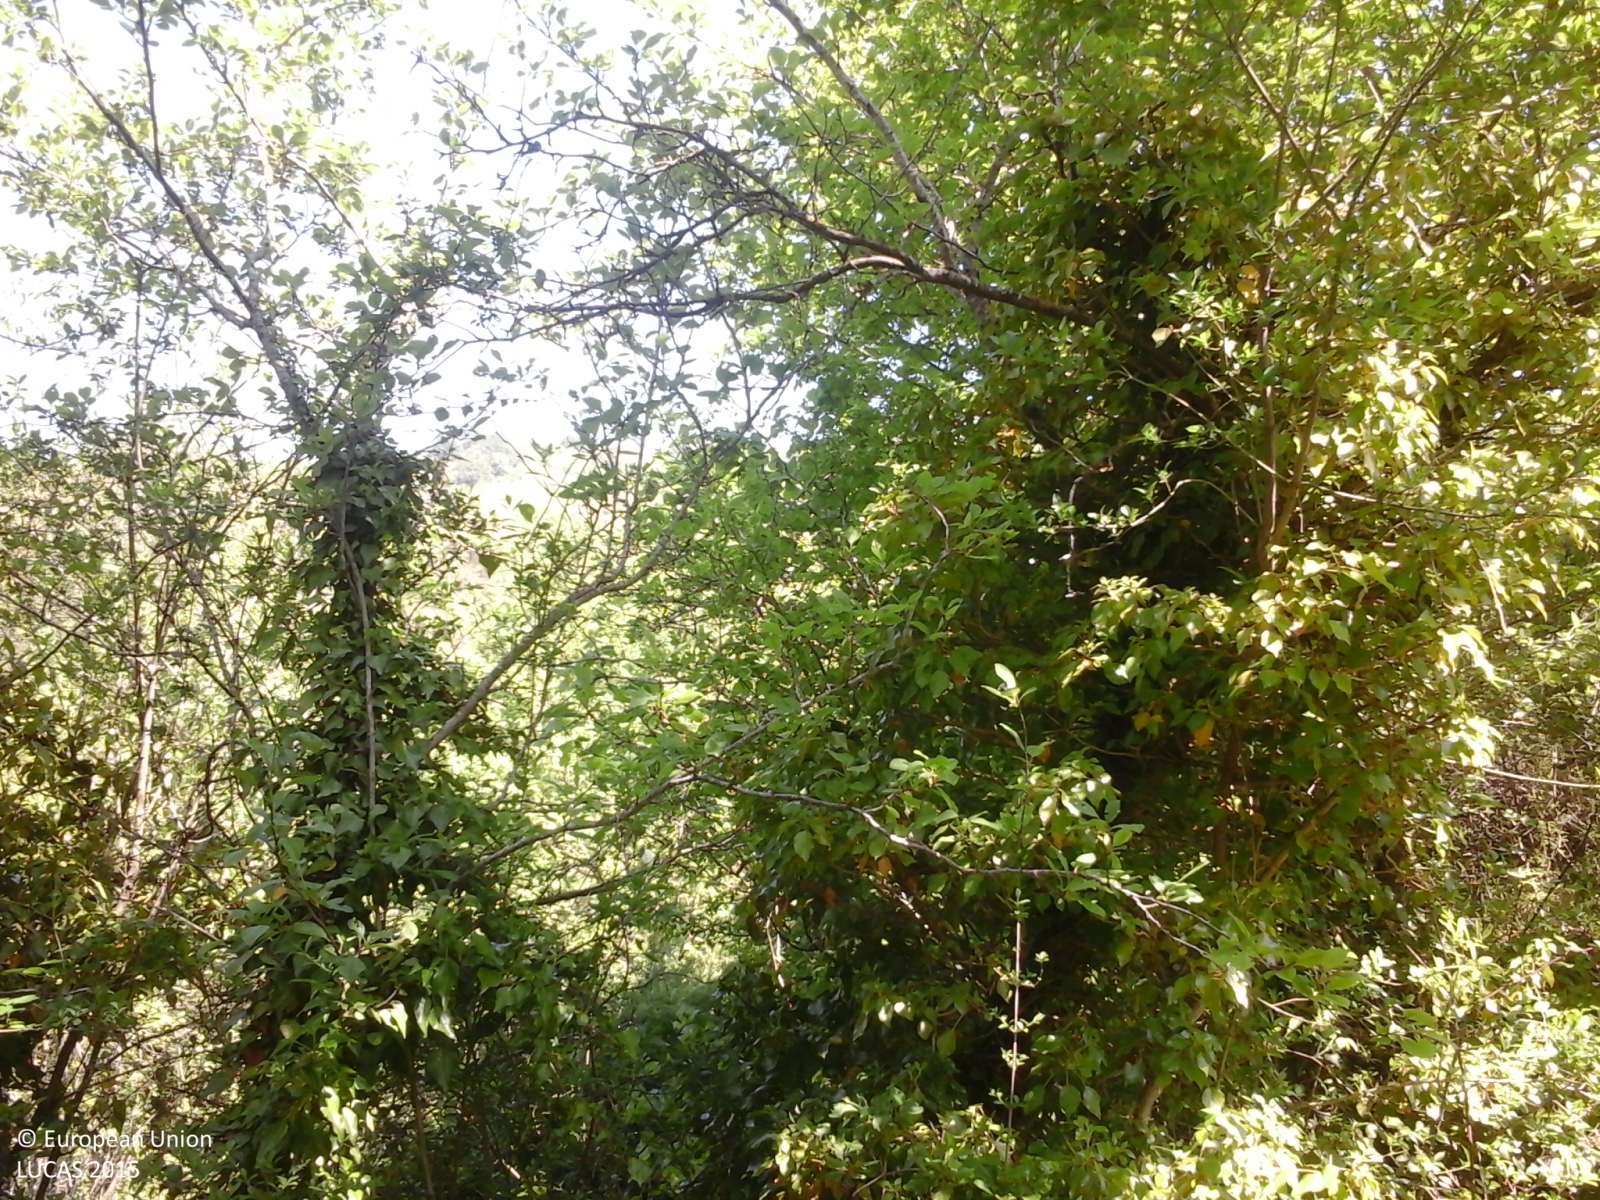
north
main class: Woodland
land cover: Broadleaved woodland
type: thermophilous deciduous forest
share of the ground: 50 - 75 %
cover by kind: broadleaved forest trees 70 %, shrubs 15 %, lichens and mosses 10 %, herbaceous plants 5 %
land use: Forestry
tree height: > 5 m
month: May
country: IT
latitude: 41.2995
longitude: 14.6286
